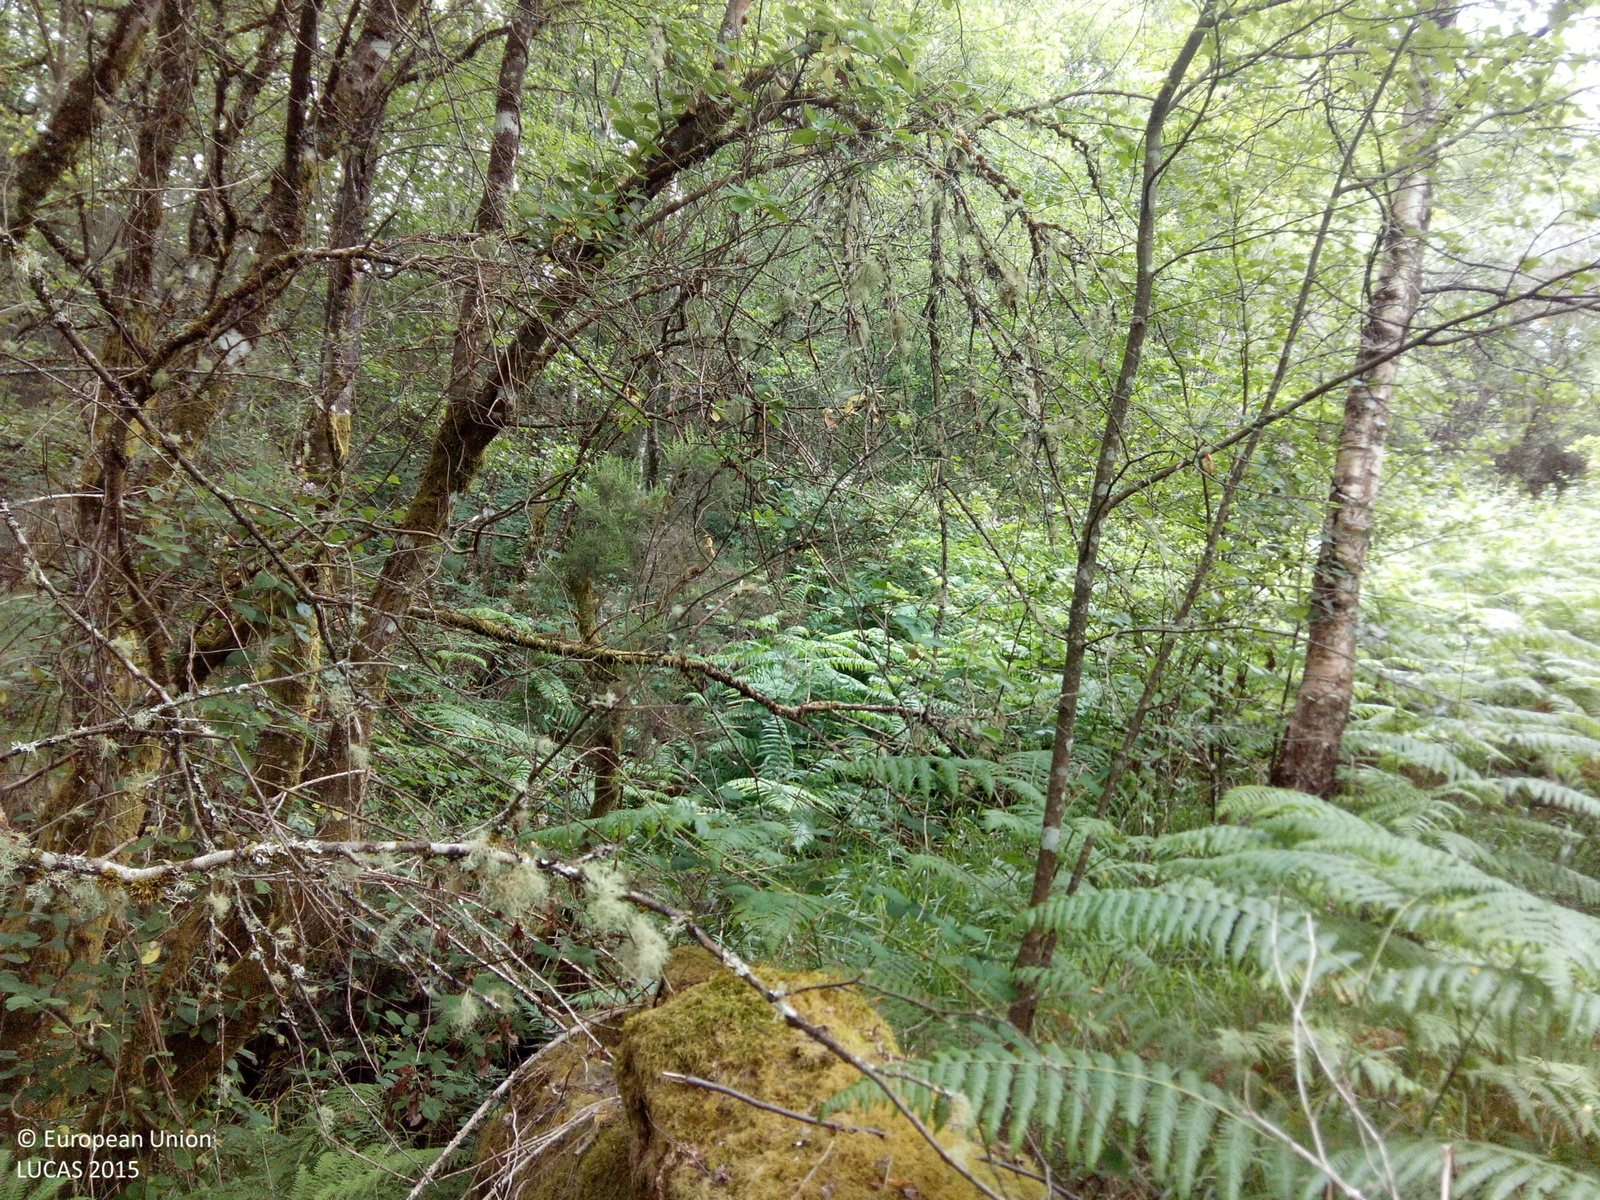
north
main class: Shrubland
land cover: Shrubland without tree cover
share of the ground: 10 - 25 %
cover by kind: consolidated bare surface 80 %, shrubs 20 %
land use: Semi-natural and natural areas not in use
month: July
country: ES
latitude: 42.2742
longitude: -8.2382
